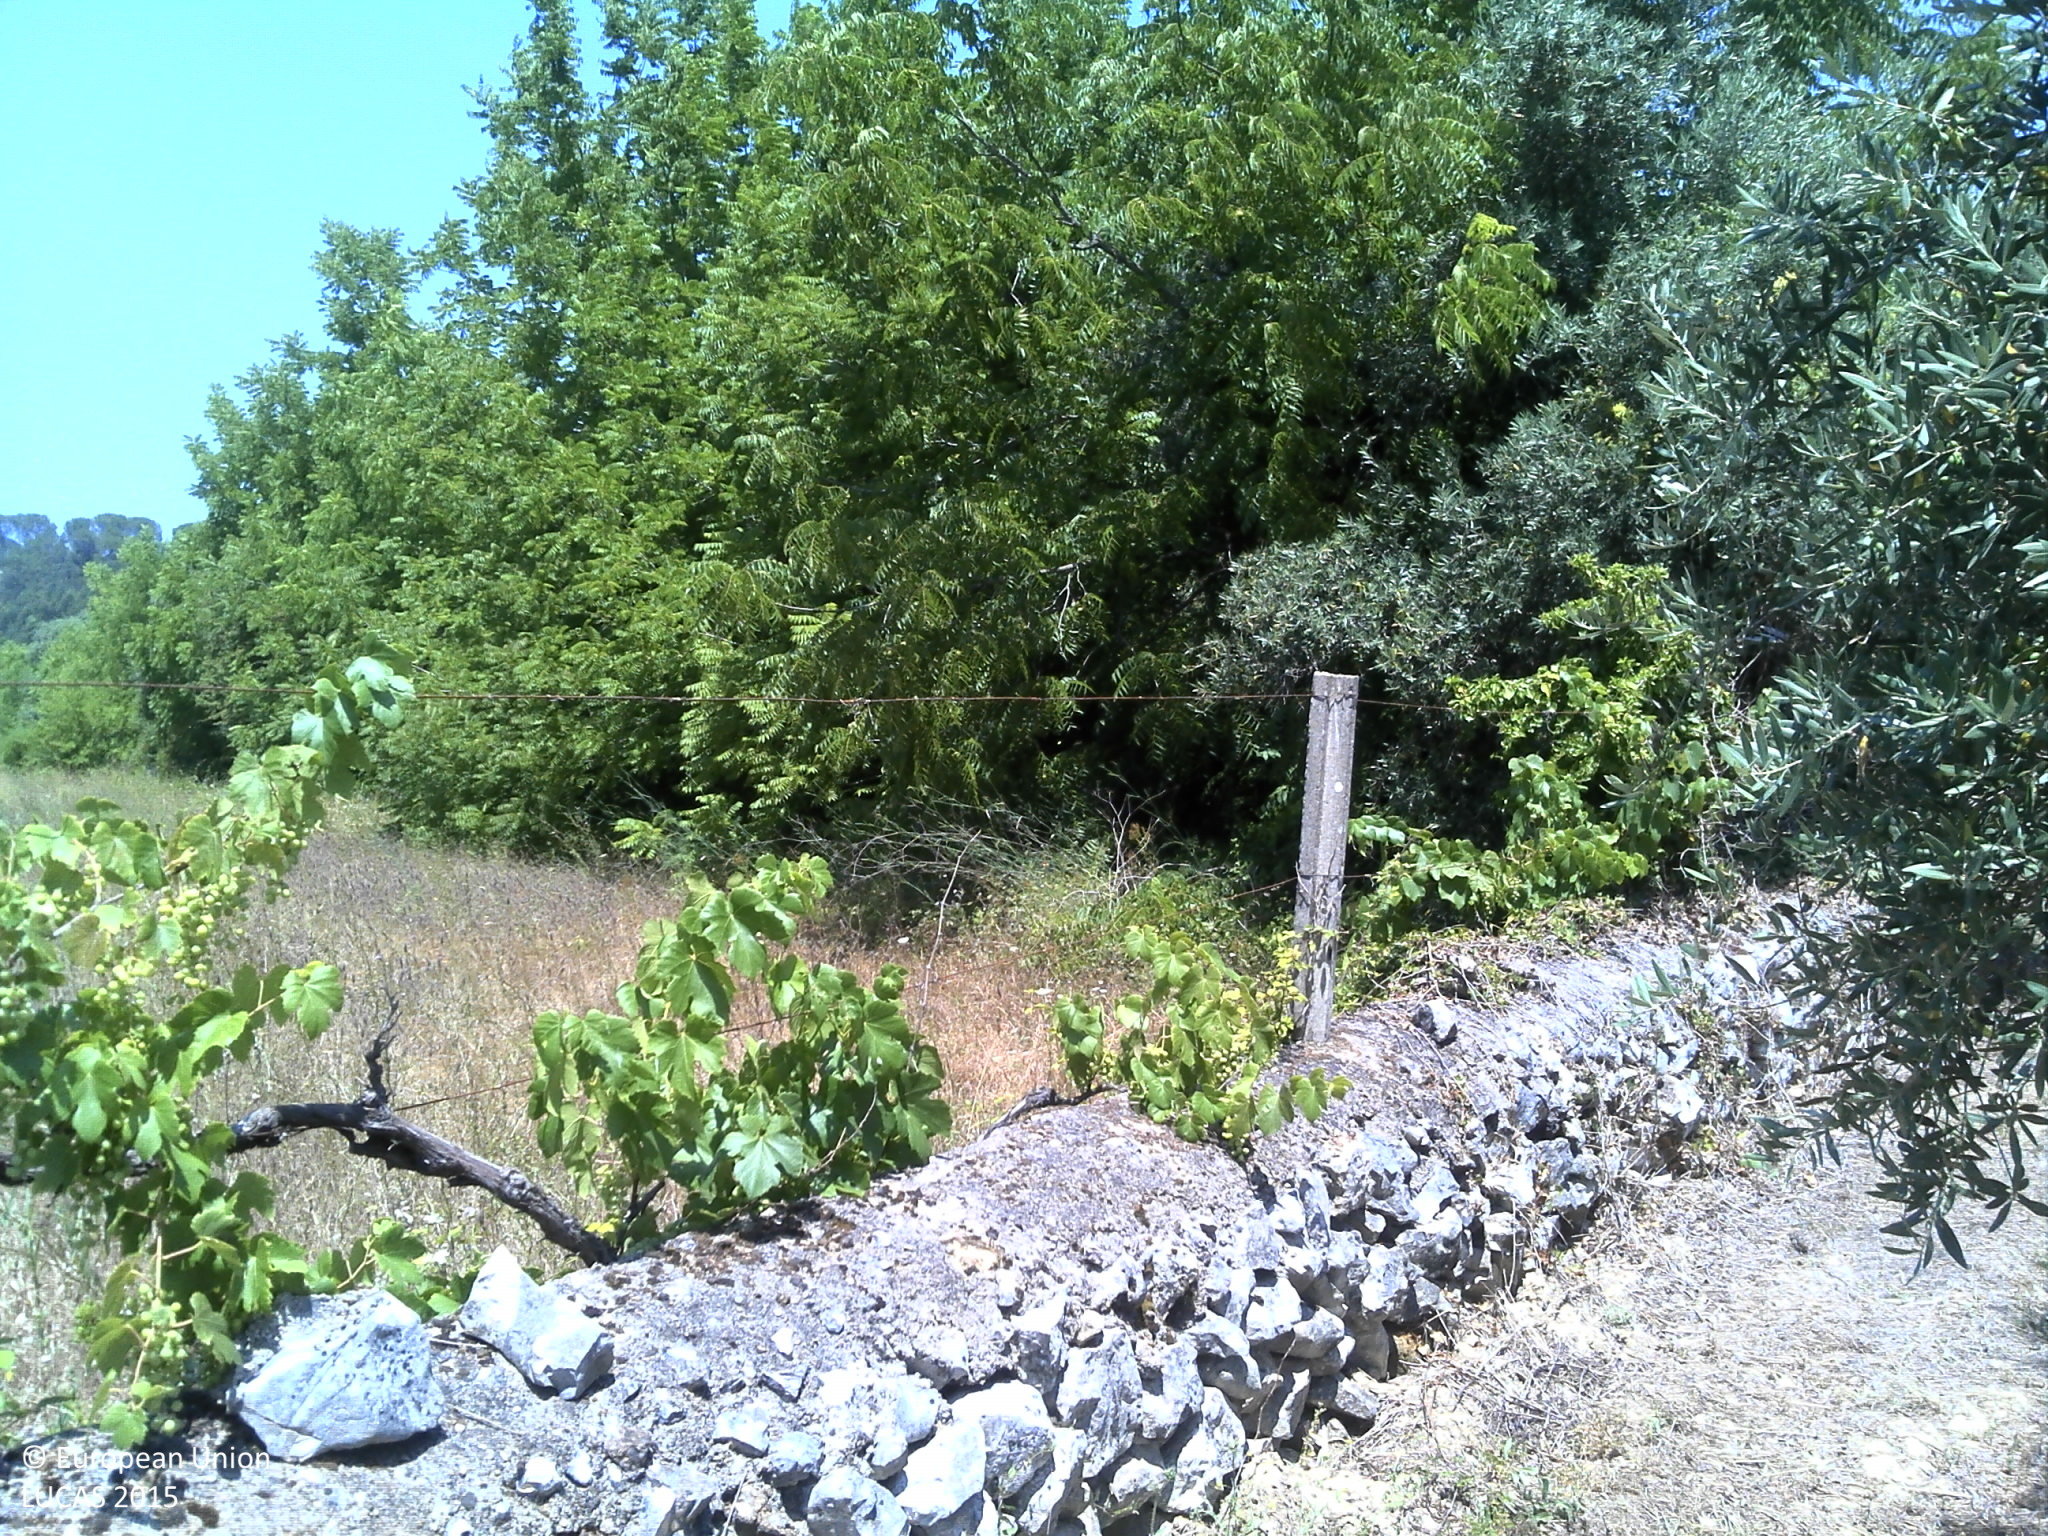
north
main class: Grassland
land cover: Grassland without tree/shrub cover
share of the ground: 50 - 75 %
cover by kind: herbaceous plants 55 %, unconsolidated bare surface 45 %
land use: Agriculture (excluding fallow land and kitchen gardens)
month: July
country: PT
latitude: 40.0978
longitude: -8.5118
